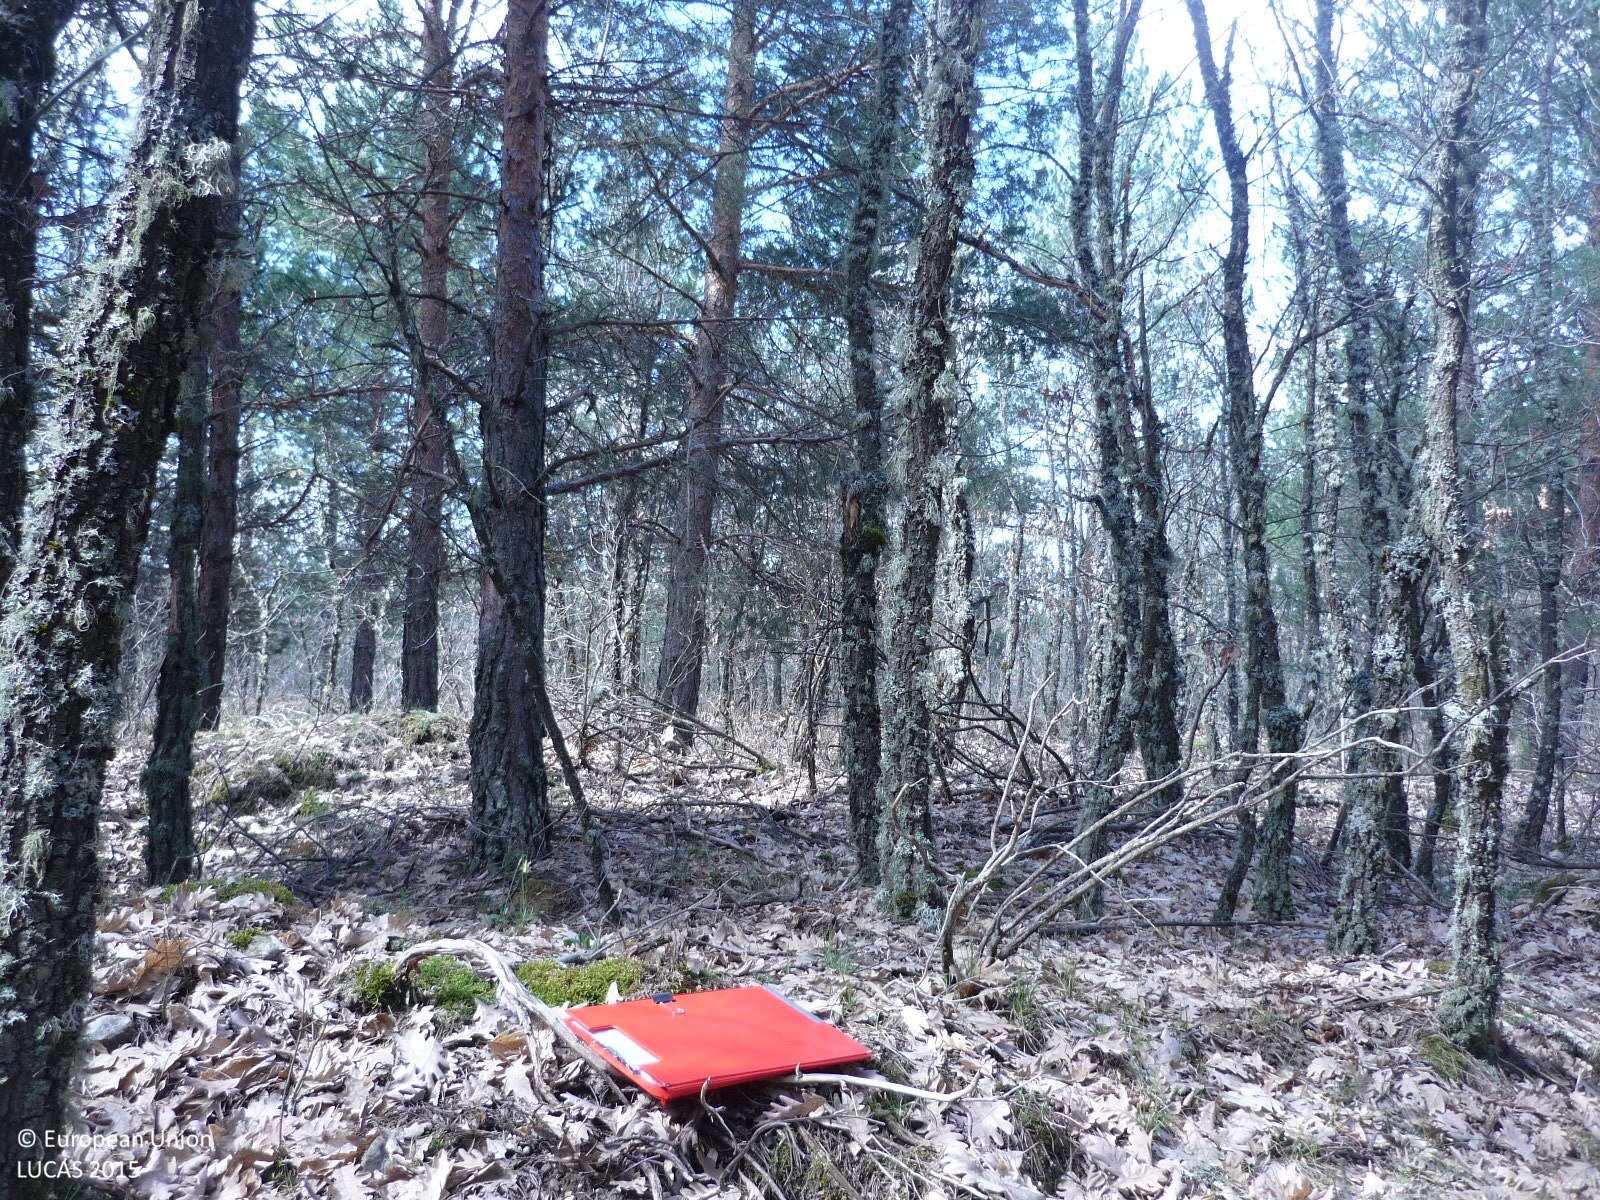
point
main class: Woodland
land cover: Pine dominated mixed woodland
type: coniferous forest of the mediterranean region
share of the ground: > 75 %
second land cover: Grassland without tree/shrub cover
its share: 10 - 25 %
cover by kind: coniferous forest trees 50 %, broadleaved forest trees 45 %, herbaceous plants 5 %
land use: Forestry
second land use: Agriculture (excluding fallow land and kitchen gardens)
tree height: > 5 m
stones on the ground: 10 - 25 %
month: April
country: ES
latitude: 41.2670
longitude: -3.5223
